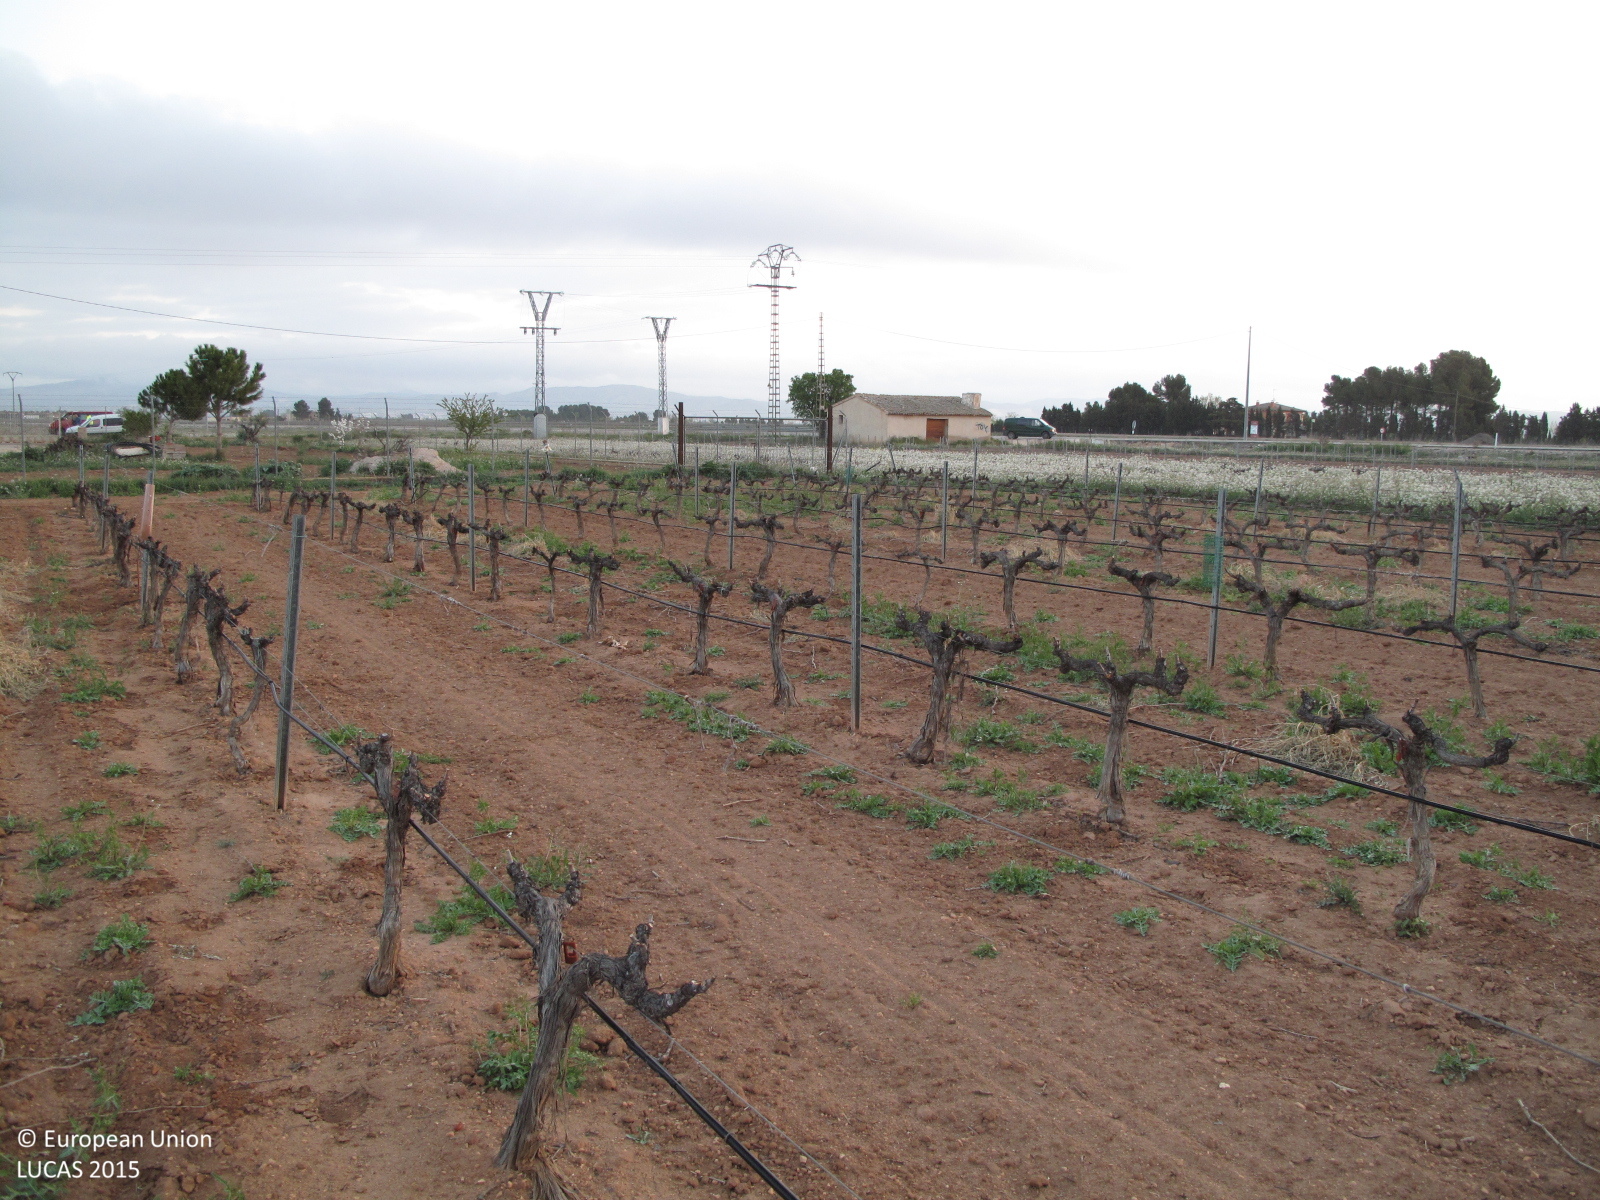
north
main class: Cropland
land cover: Vineyards
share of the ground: < 10 %
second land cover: Other bare soil
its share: > 75 %
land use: Agriculture (excluding fallow land and kitchen gardens)
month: April
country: ES
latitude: 38.5622
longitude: -1.0650
